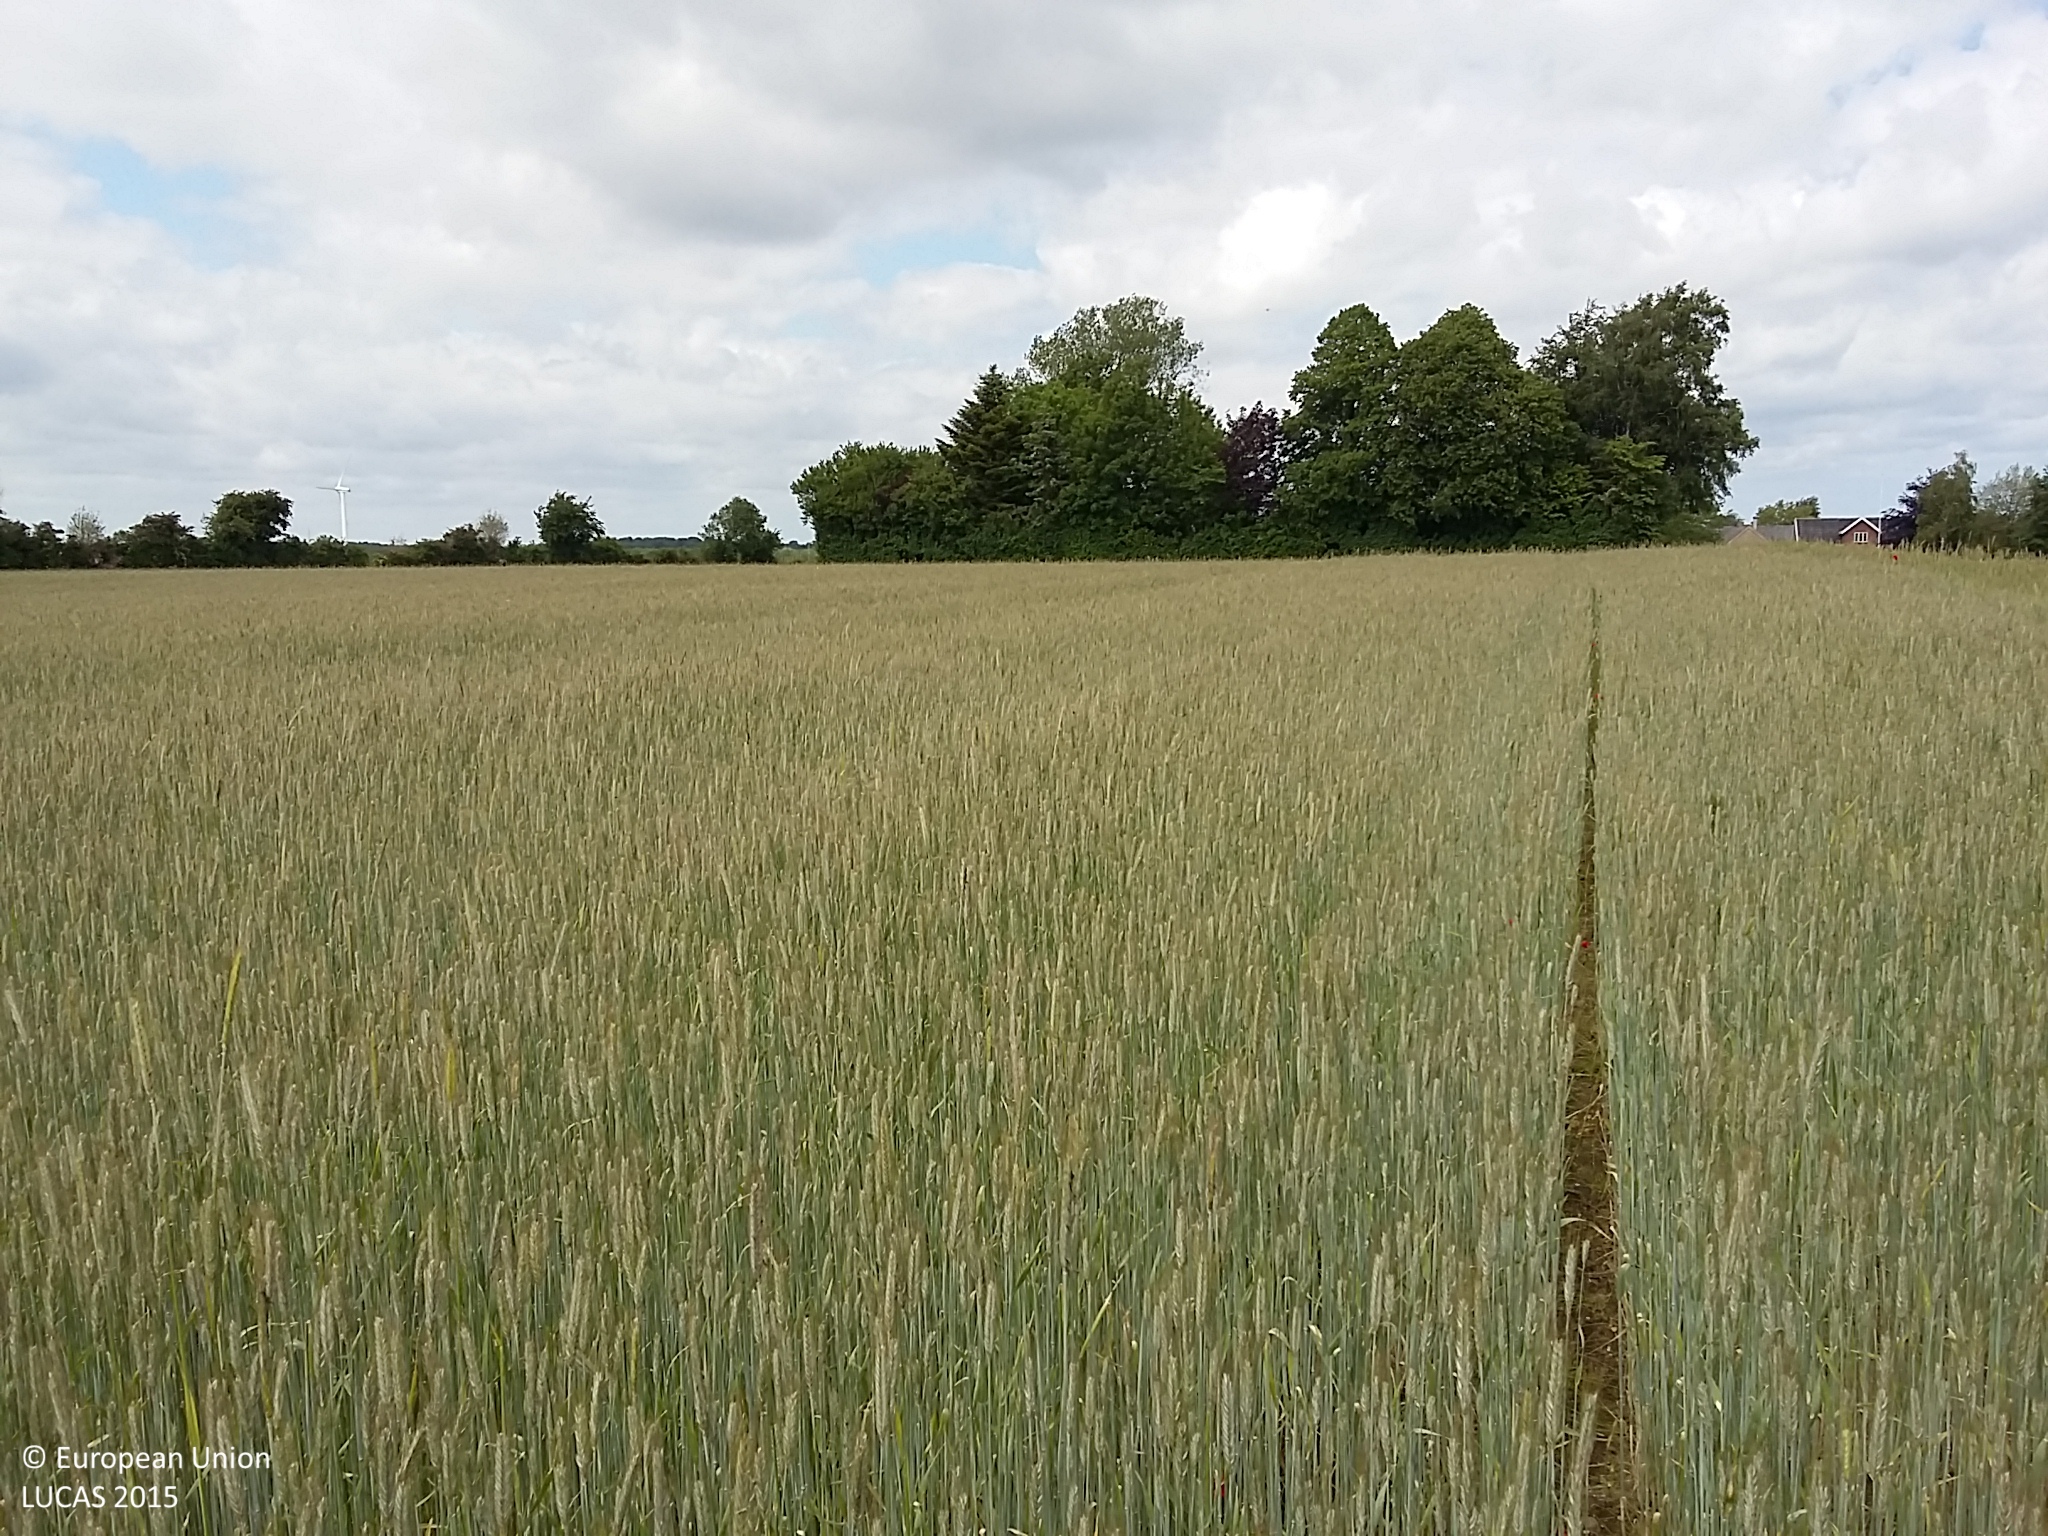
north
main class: Cropland
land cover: Rye
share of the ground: > 75 %
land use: Agriculture (excluding fallow land and kitchen gardens)
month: June
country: DK
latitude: 55.3055
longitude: 10.6138
